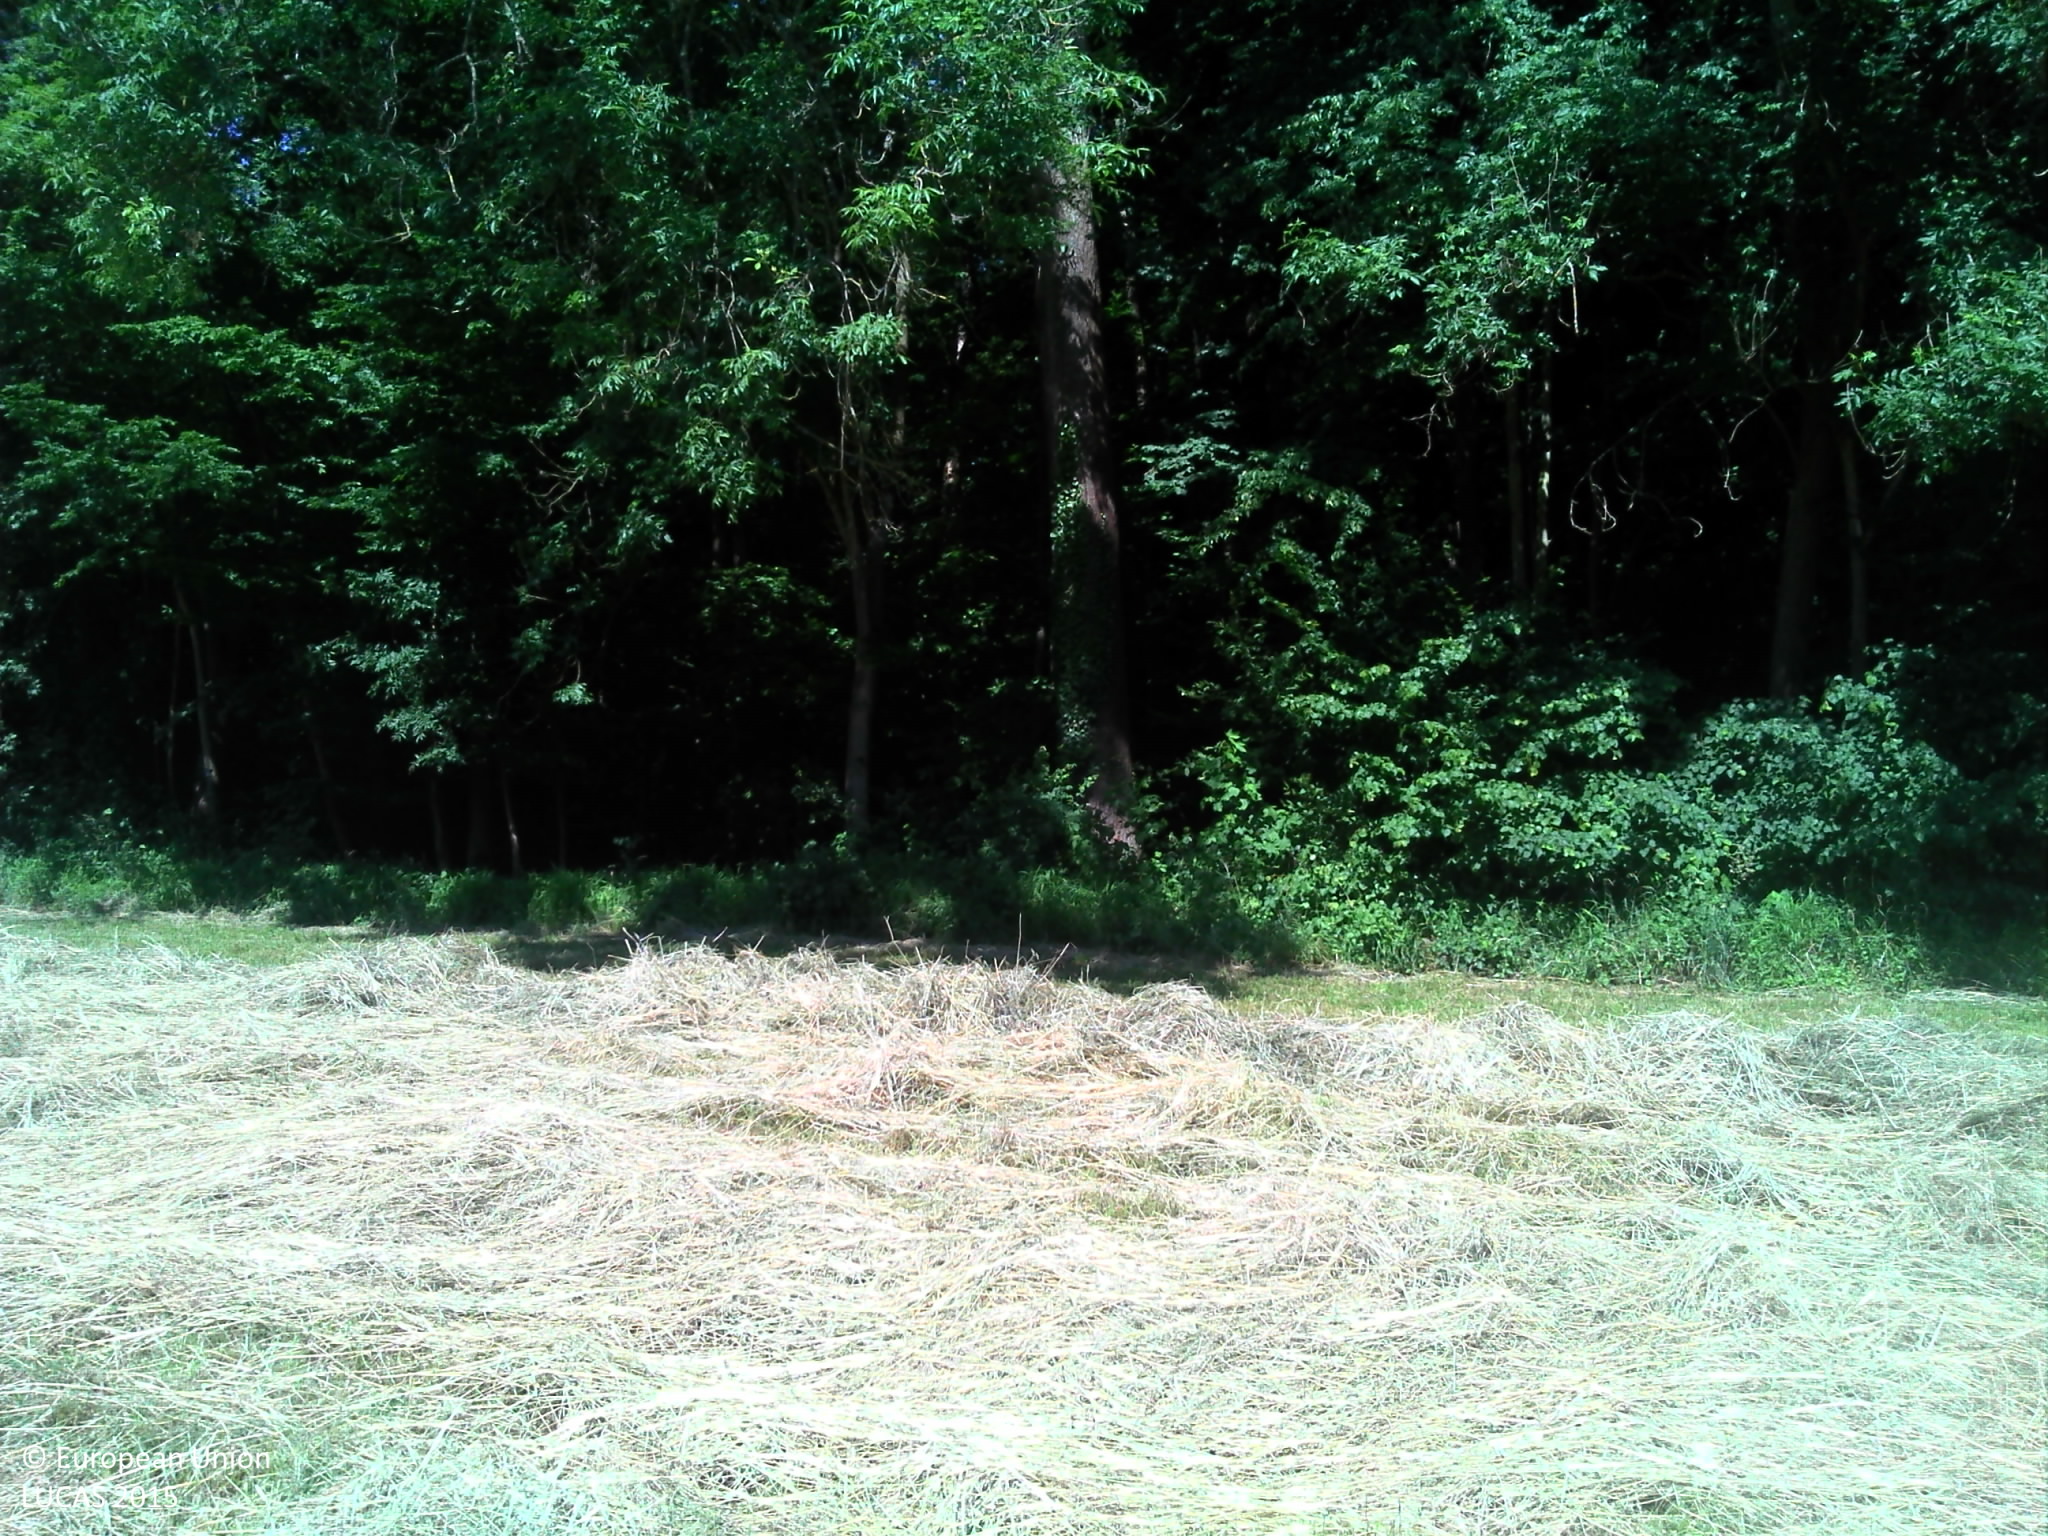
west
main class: Grassland
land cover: Grassland without tree/shrub cover
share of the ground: > 75 %
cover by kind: herbaceous plants 100 %
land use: Agriculture (excluding fallow land and kitchen gardens)
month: June
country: FR
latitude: 48.3968
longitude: 7.6643
